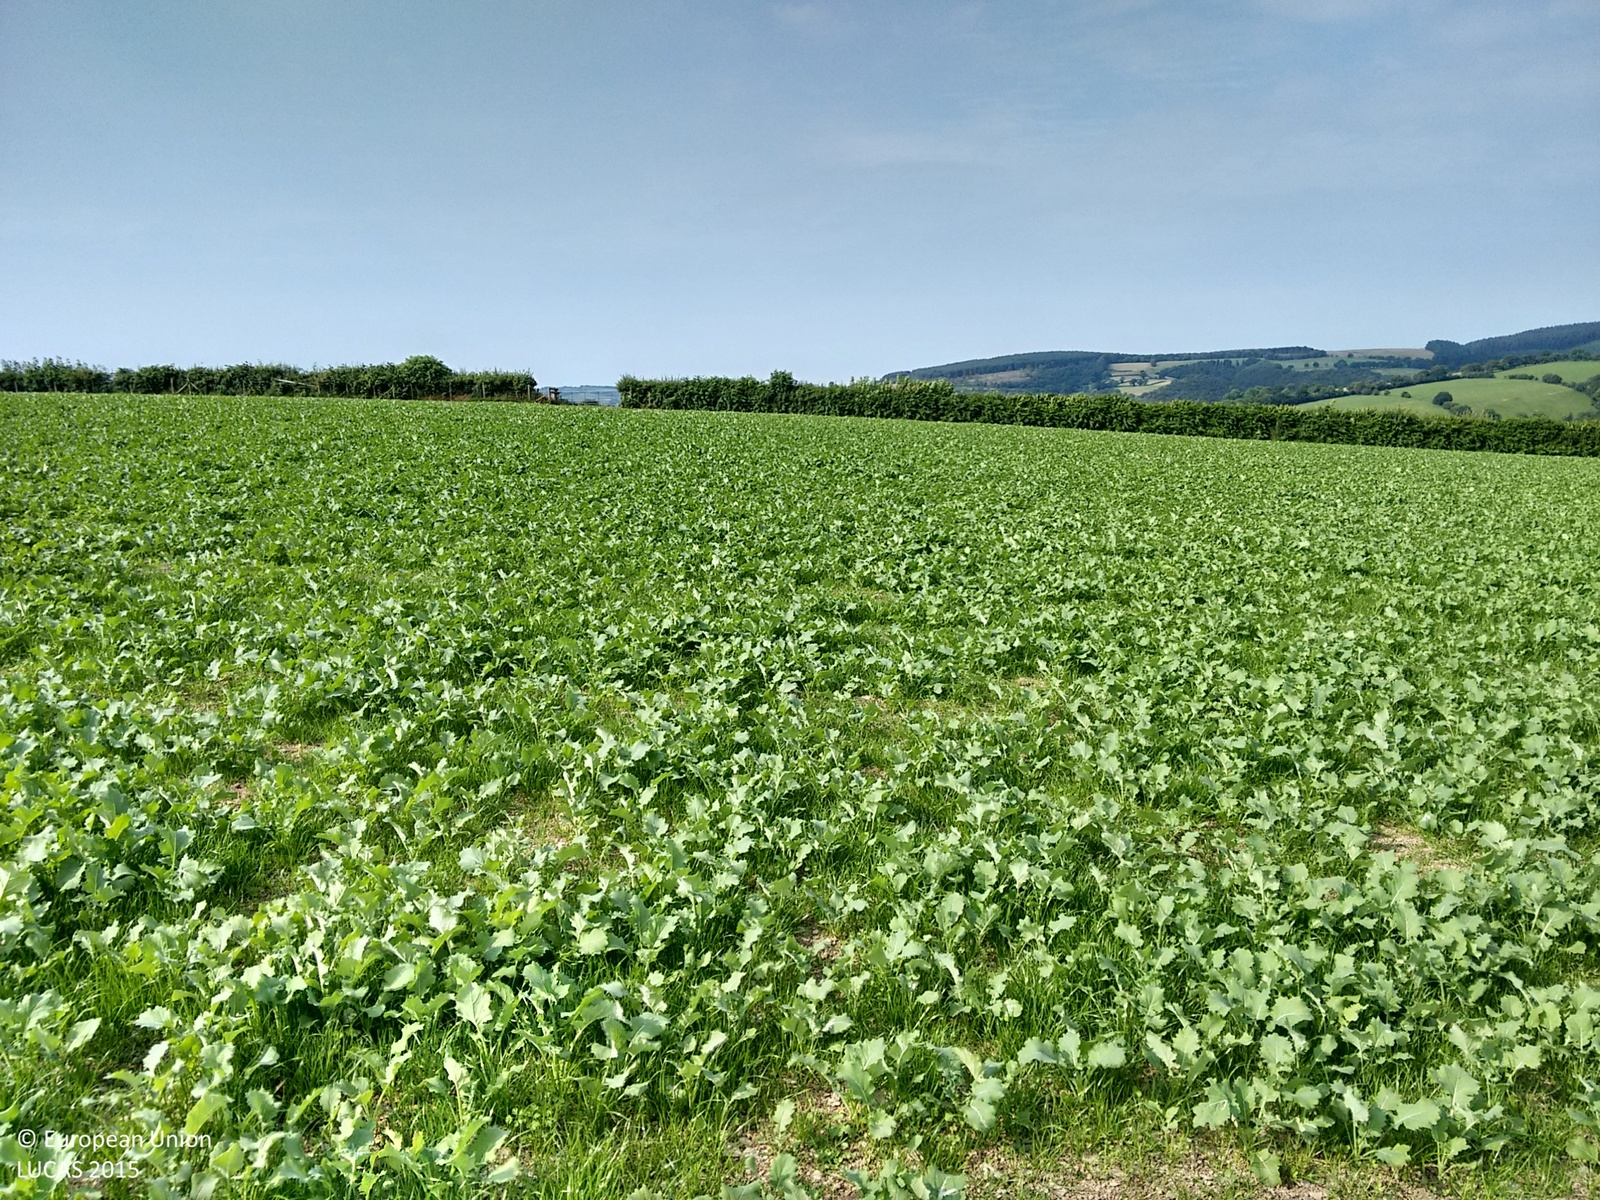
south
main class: Cropland
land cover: Sugar beet
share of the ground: > 75 %
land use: Agriculture (excluding fallow land and kitchen gardens)
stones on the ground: 10 - 25 %
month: August
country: GB
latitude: 52.0158
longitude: -4.0101
